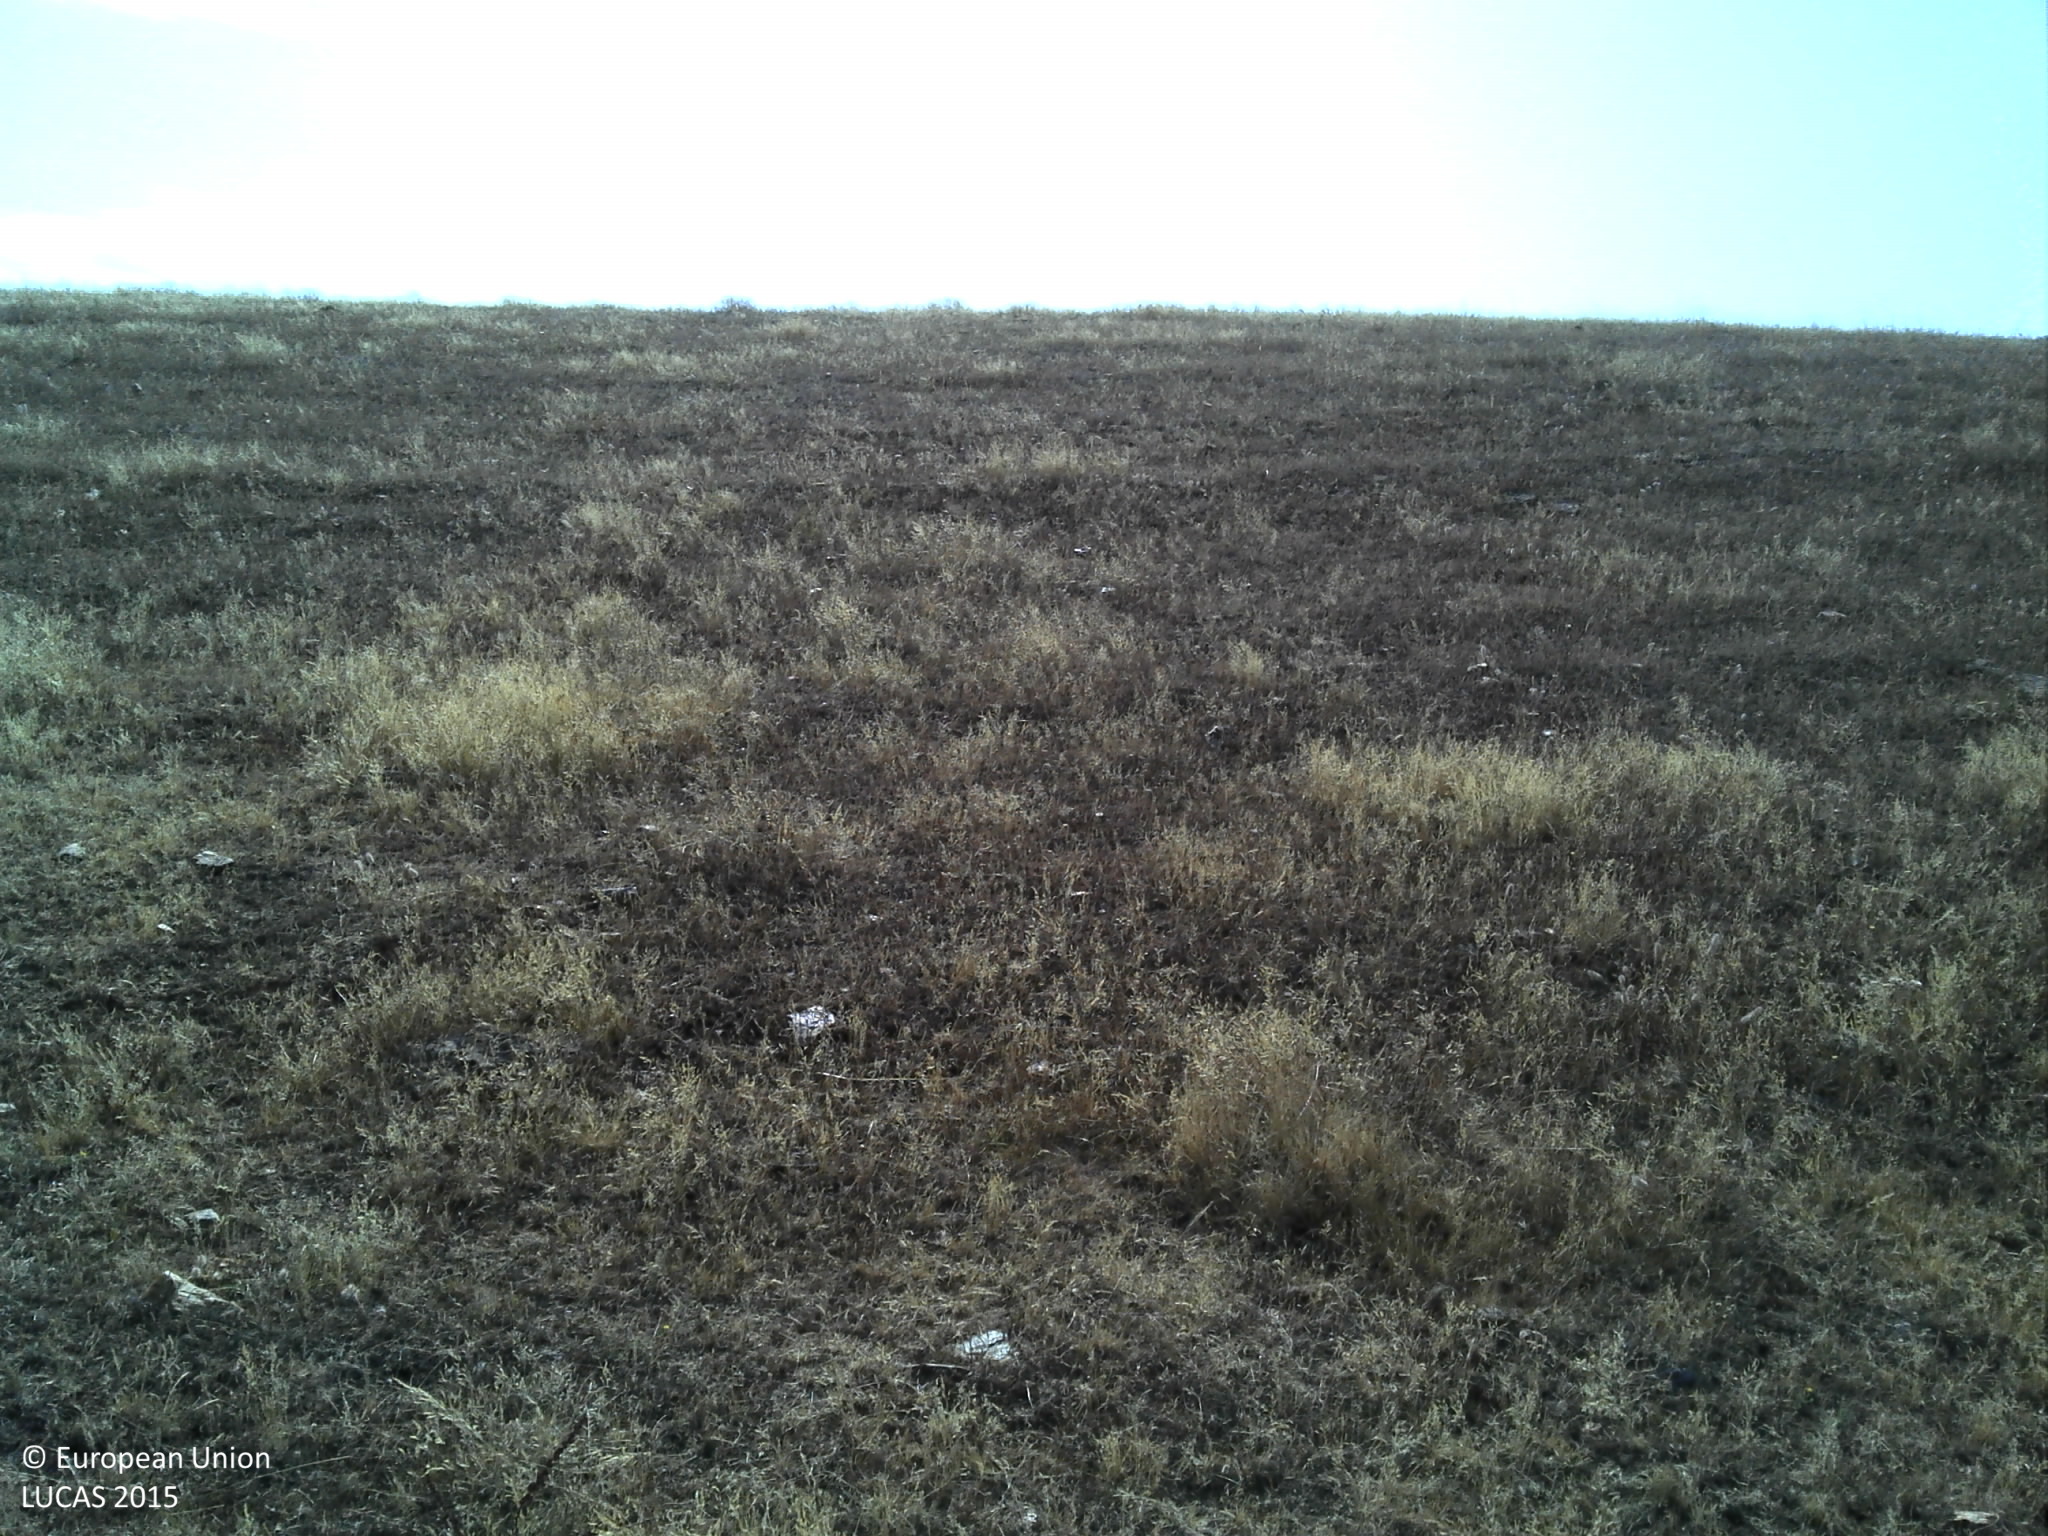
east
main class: Grassland
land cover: Grassland with sparse tree/shrub cover
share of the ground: 50 - 75 %
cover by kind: herbaceous plants 75 %, unconsolidated bare surface 20 %, broadleaved forest trees 5 %
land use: Agriculture (excluding fallow land and kitchen gardens)
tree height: < 5 m
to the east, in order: Grassland with sparse tree/shrub cover; Grassland without tree/shrub cover; Single bushes/trees; Grassland without tree/shrub cover; Rivers and streams; Grassland without tree/shrub cover; Broadleaved woodland
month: June
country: PT
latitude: 37.7383
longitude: -7.5008
